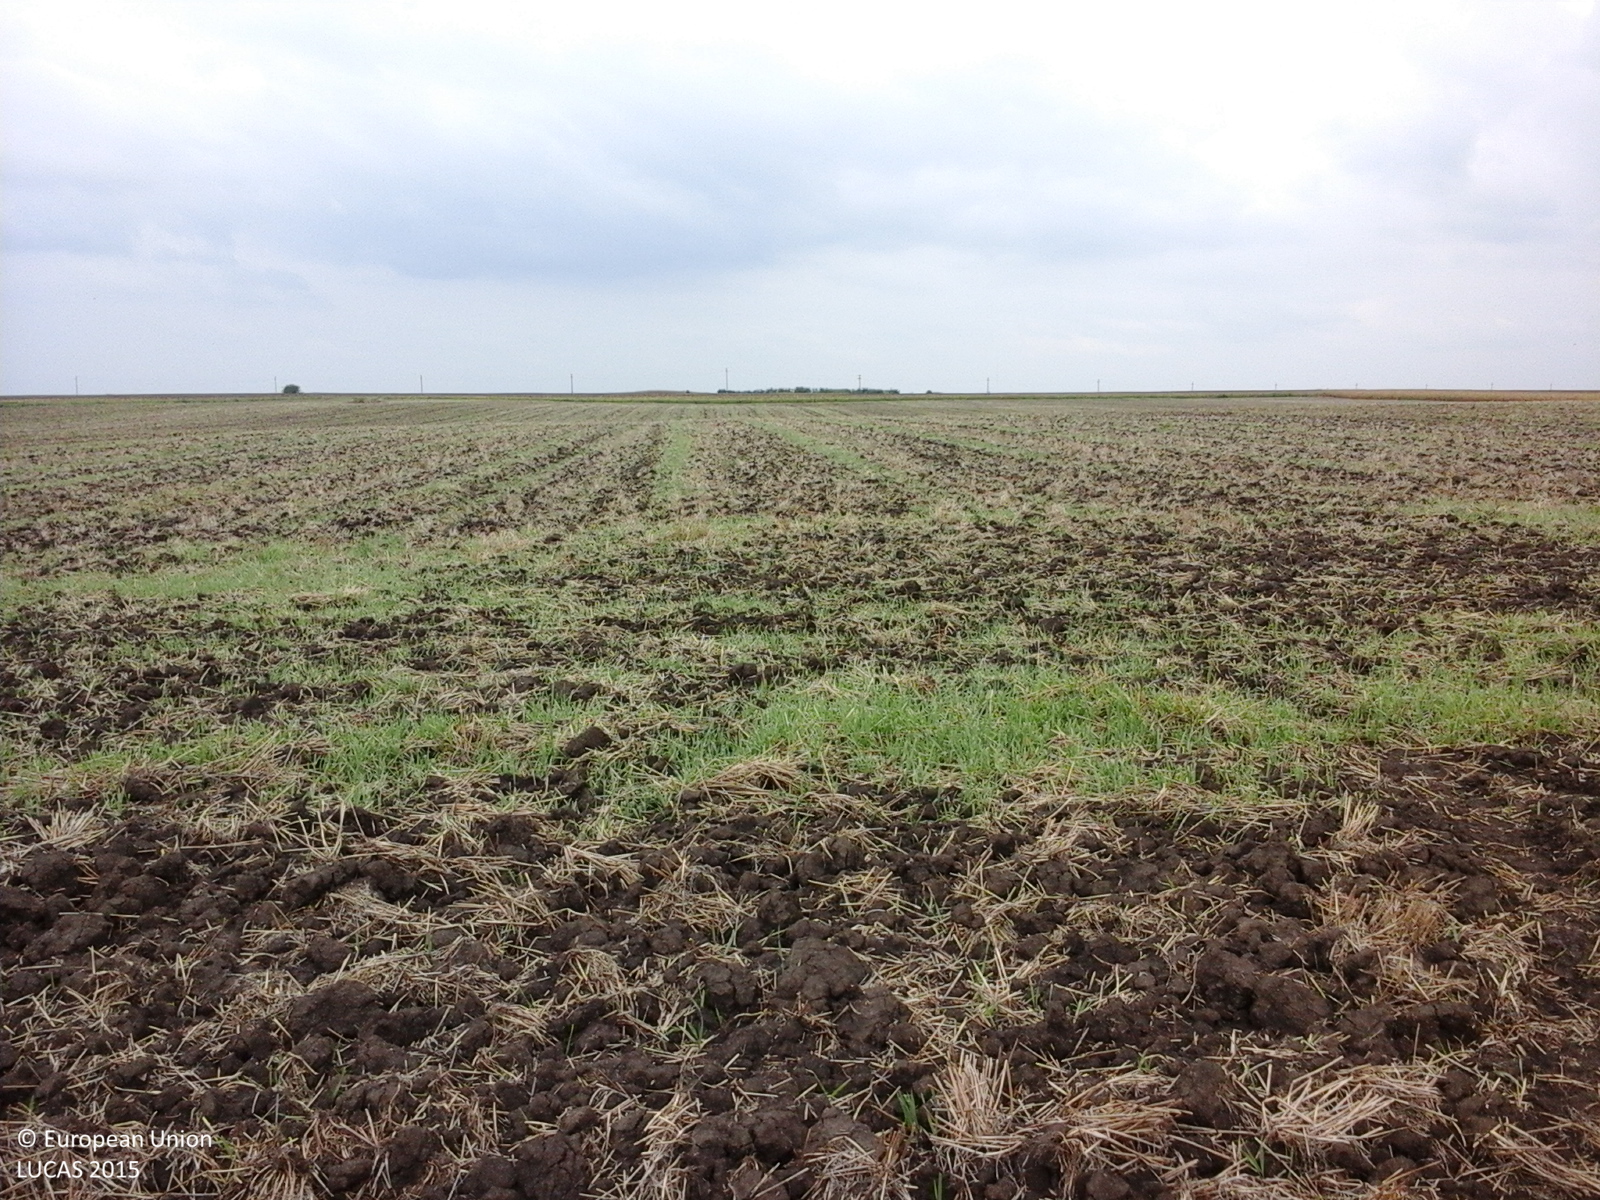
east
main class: Cropland
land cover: Sunflower
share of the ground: > 75 %
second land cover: Spontaneously vegetated surfaces
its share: 50 - 75 %
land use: Agriculture (excluding fallow land and kitchen gardens)
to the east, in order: Sunflower; Spontaneously vegetated surfaces; Tracks; Grass margins; Common wheat
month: August
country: RO
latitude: 45.9654
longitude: 20.9848
